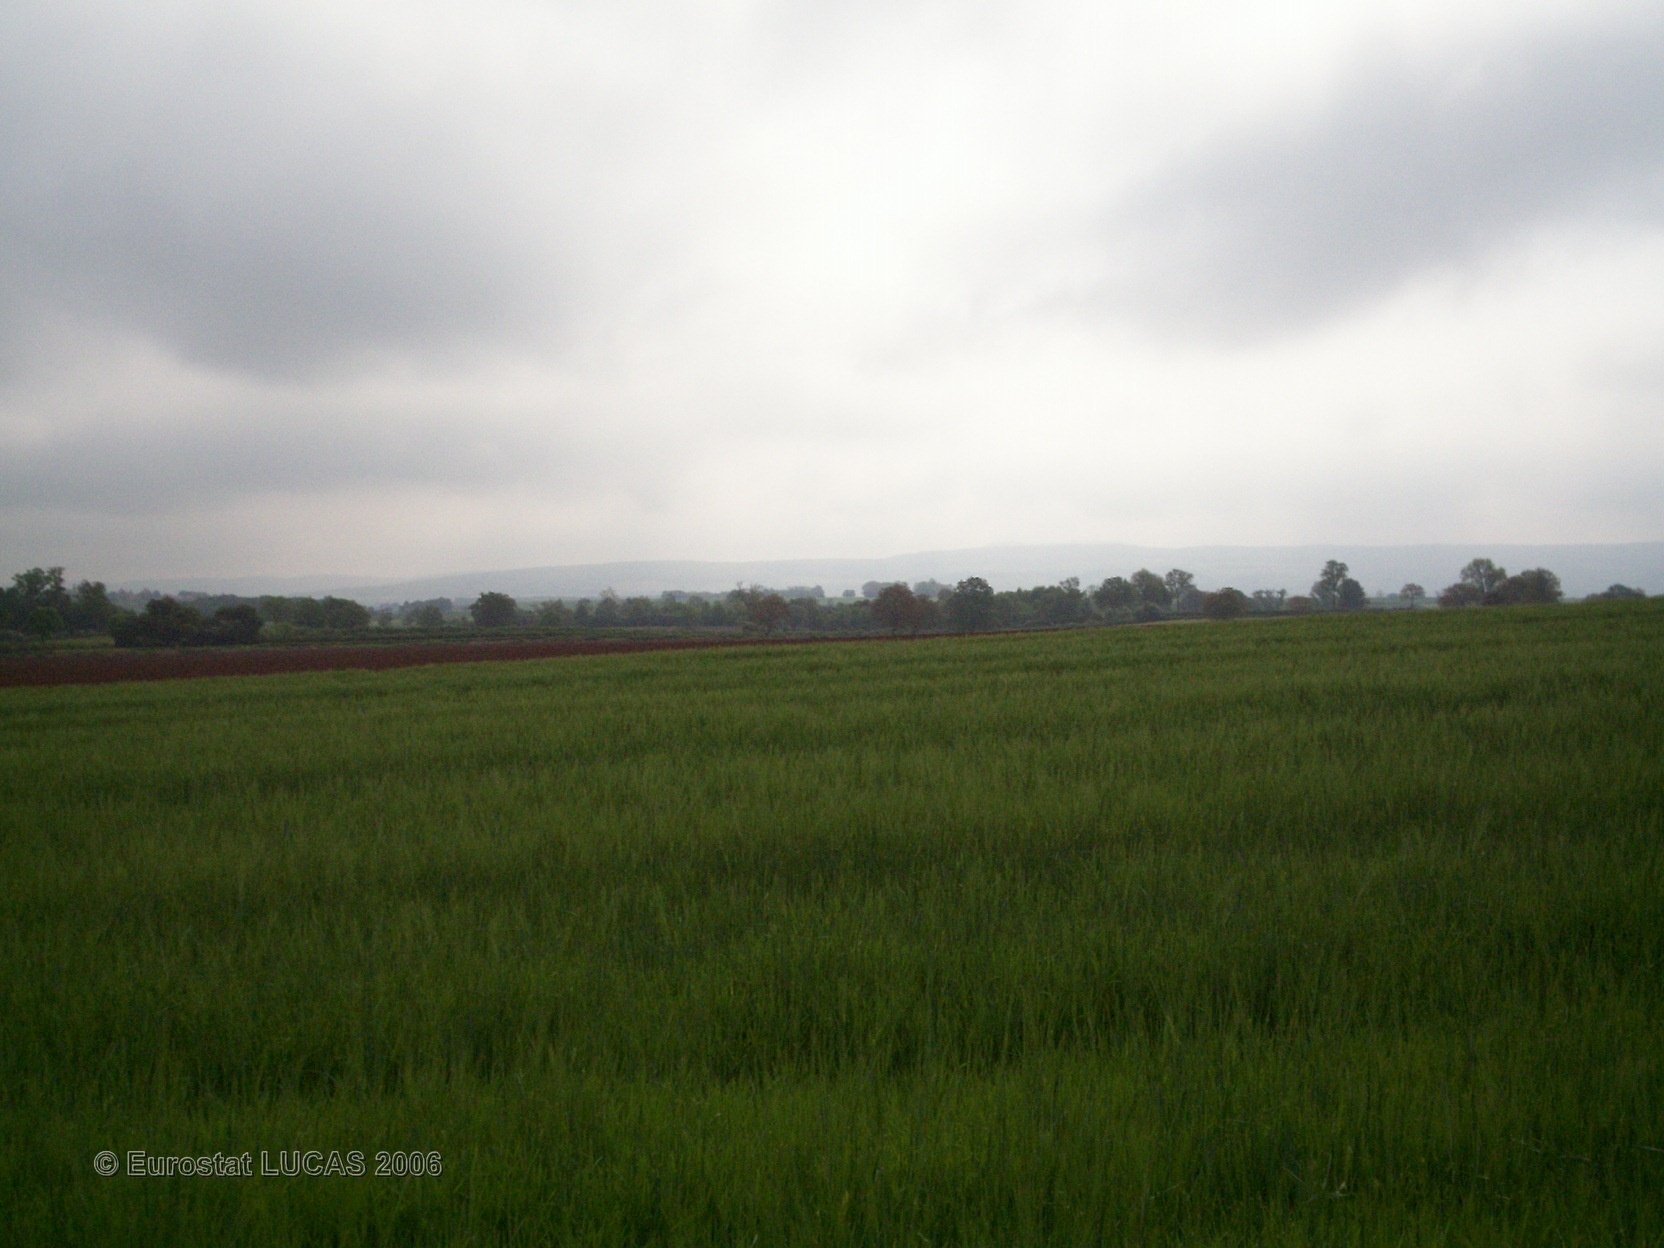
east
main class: Cropland
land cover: Barley
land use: Agriculture (excluding fallow land and kitchen gardens)
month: May
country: FR
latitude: 46.5059
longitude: 4.6455
